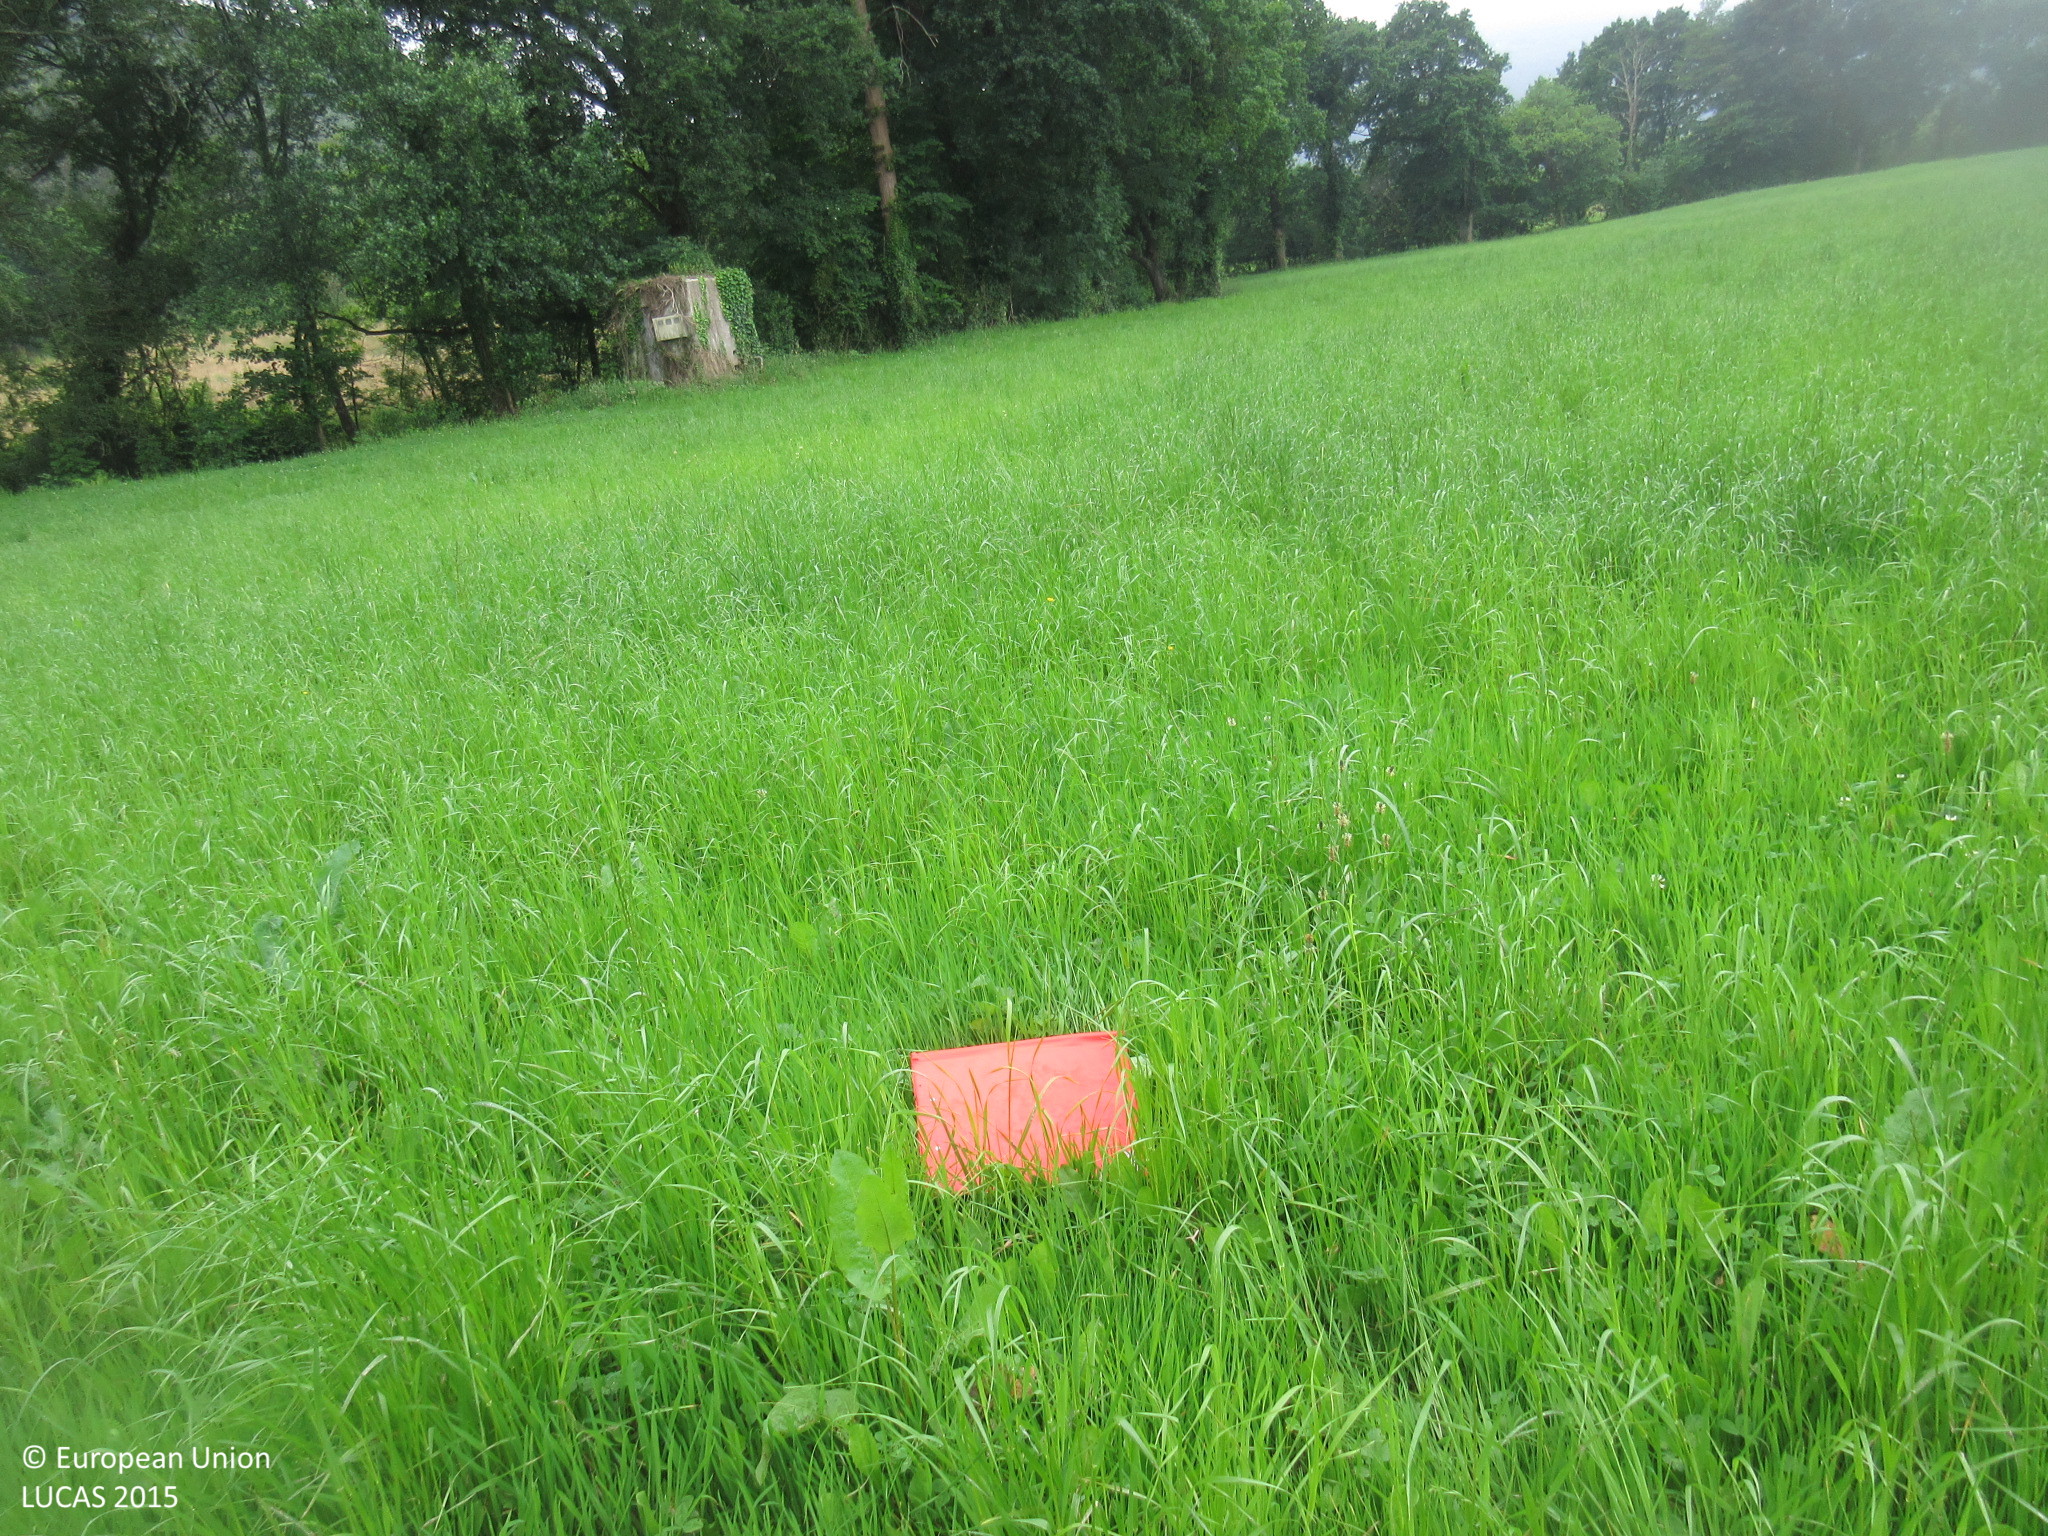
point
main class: Grassland
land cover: Grassland without tree/shrub cover
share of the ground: > 75 %
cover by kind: herbaceous plants 100 %
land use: Agriculture (excluding fallow land and kitchen gardens)
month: June
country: ES
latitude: 43.3504
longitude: -3.5281
